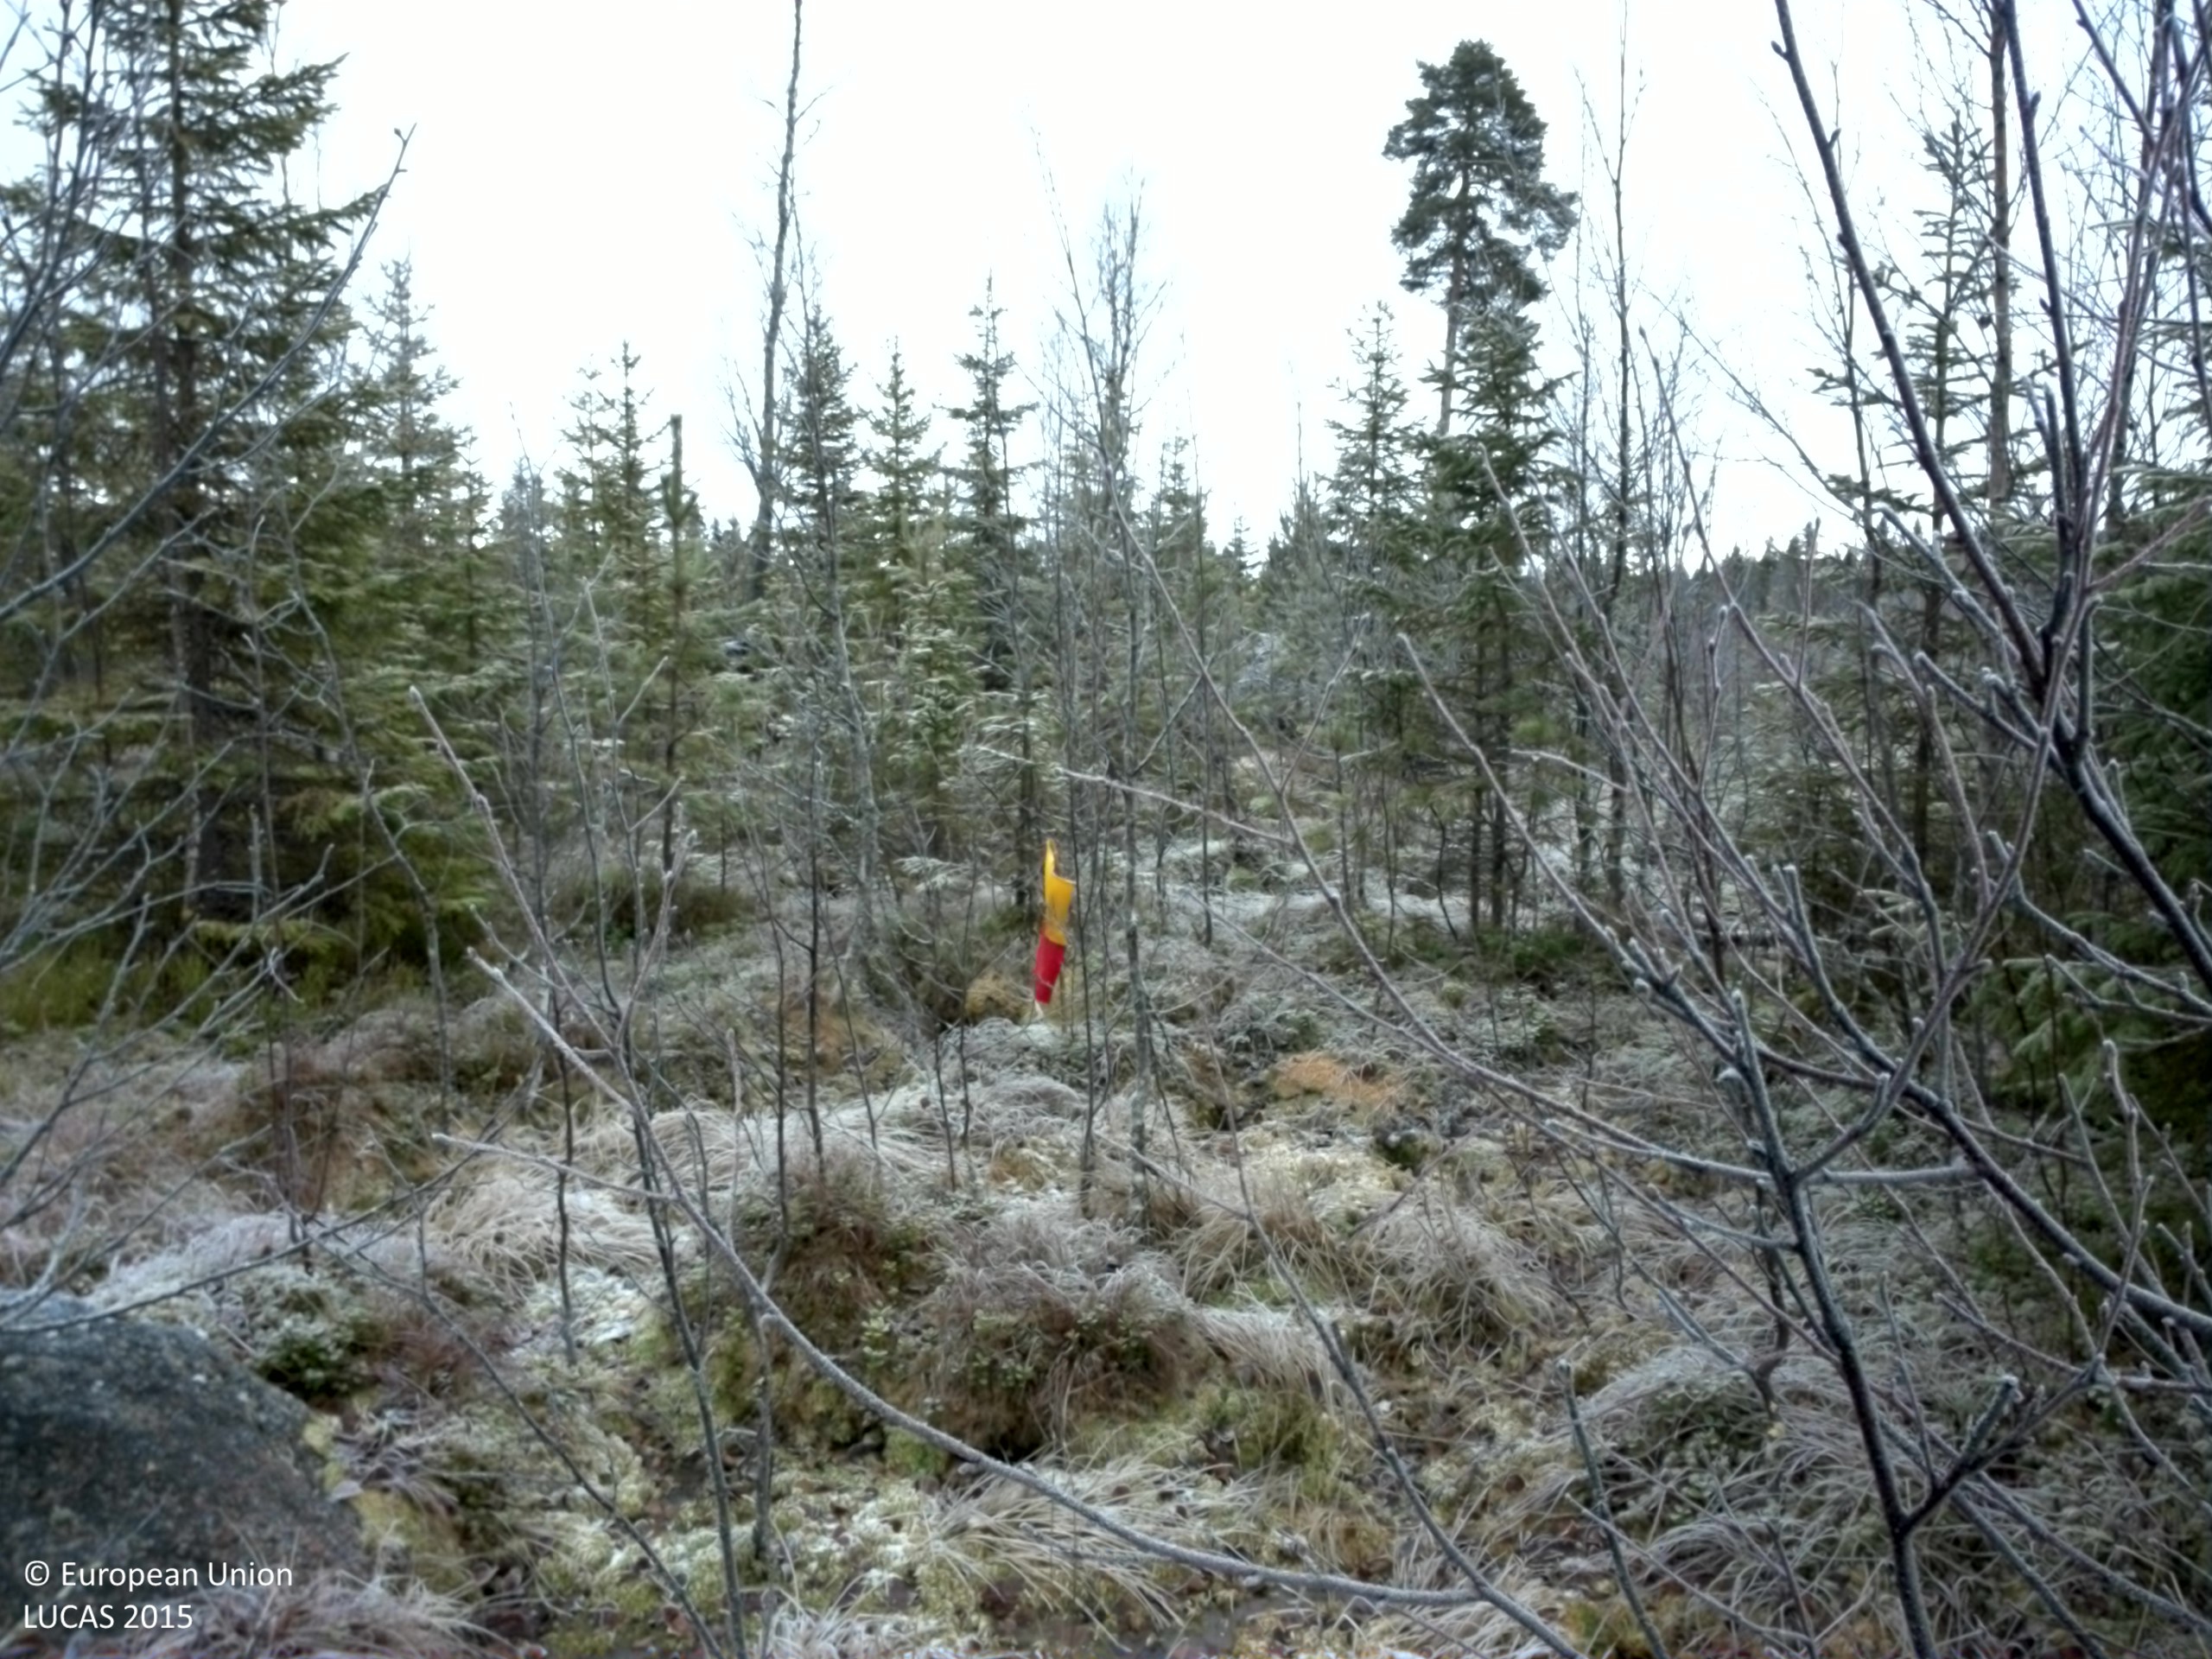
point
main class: Woodland
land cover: Spruce dominated mixed woodland
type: boreal forest
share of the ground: 25 - 50 %
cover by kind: shrubs 30 %, coniferous forest trees 25 %, lichens and mosses 20 %, herbaceous plants 15 %, broadleaved forest trees 10 %
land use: Forestry
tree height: < 5 m
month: November
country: SE
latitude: 63.7628
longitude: 15.9134
